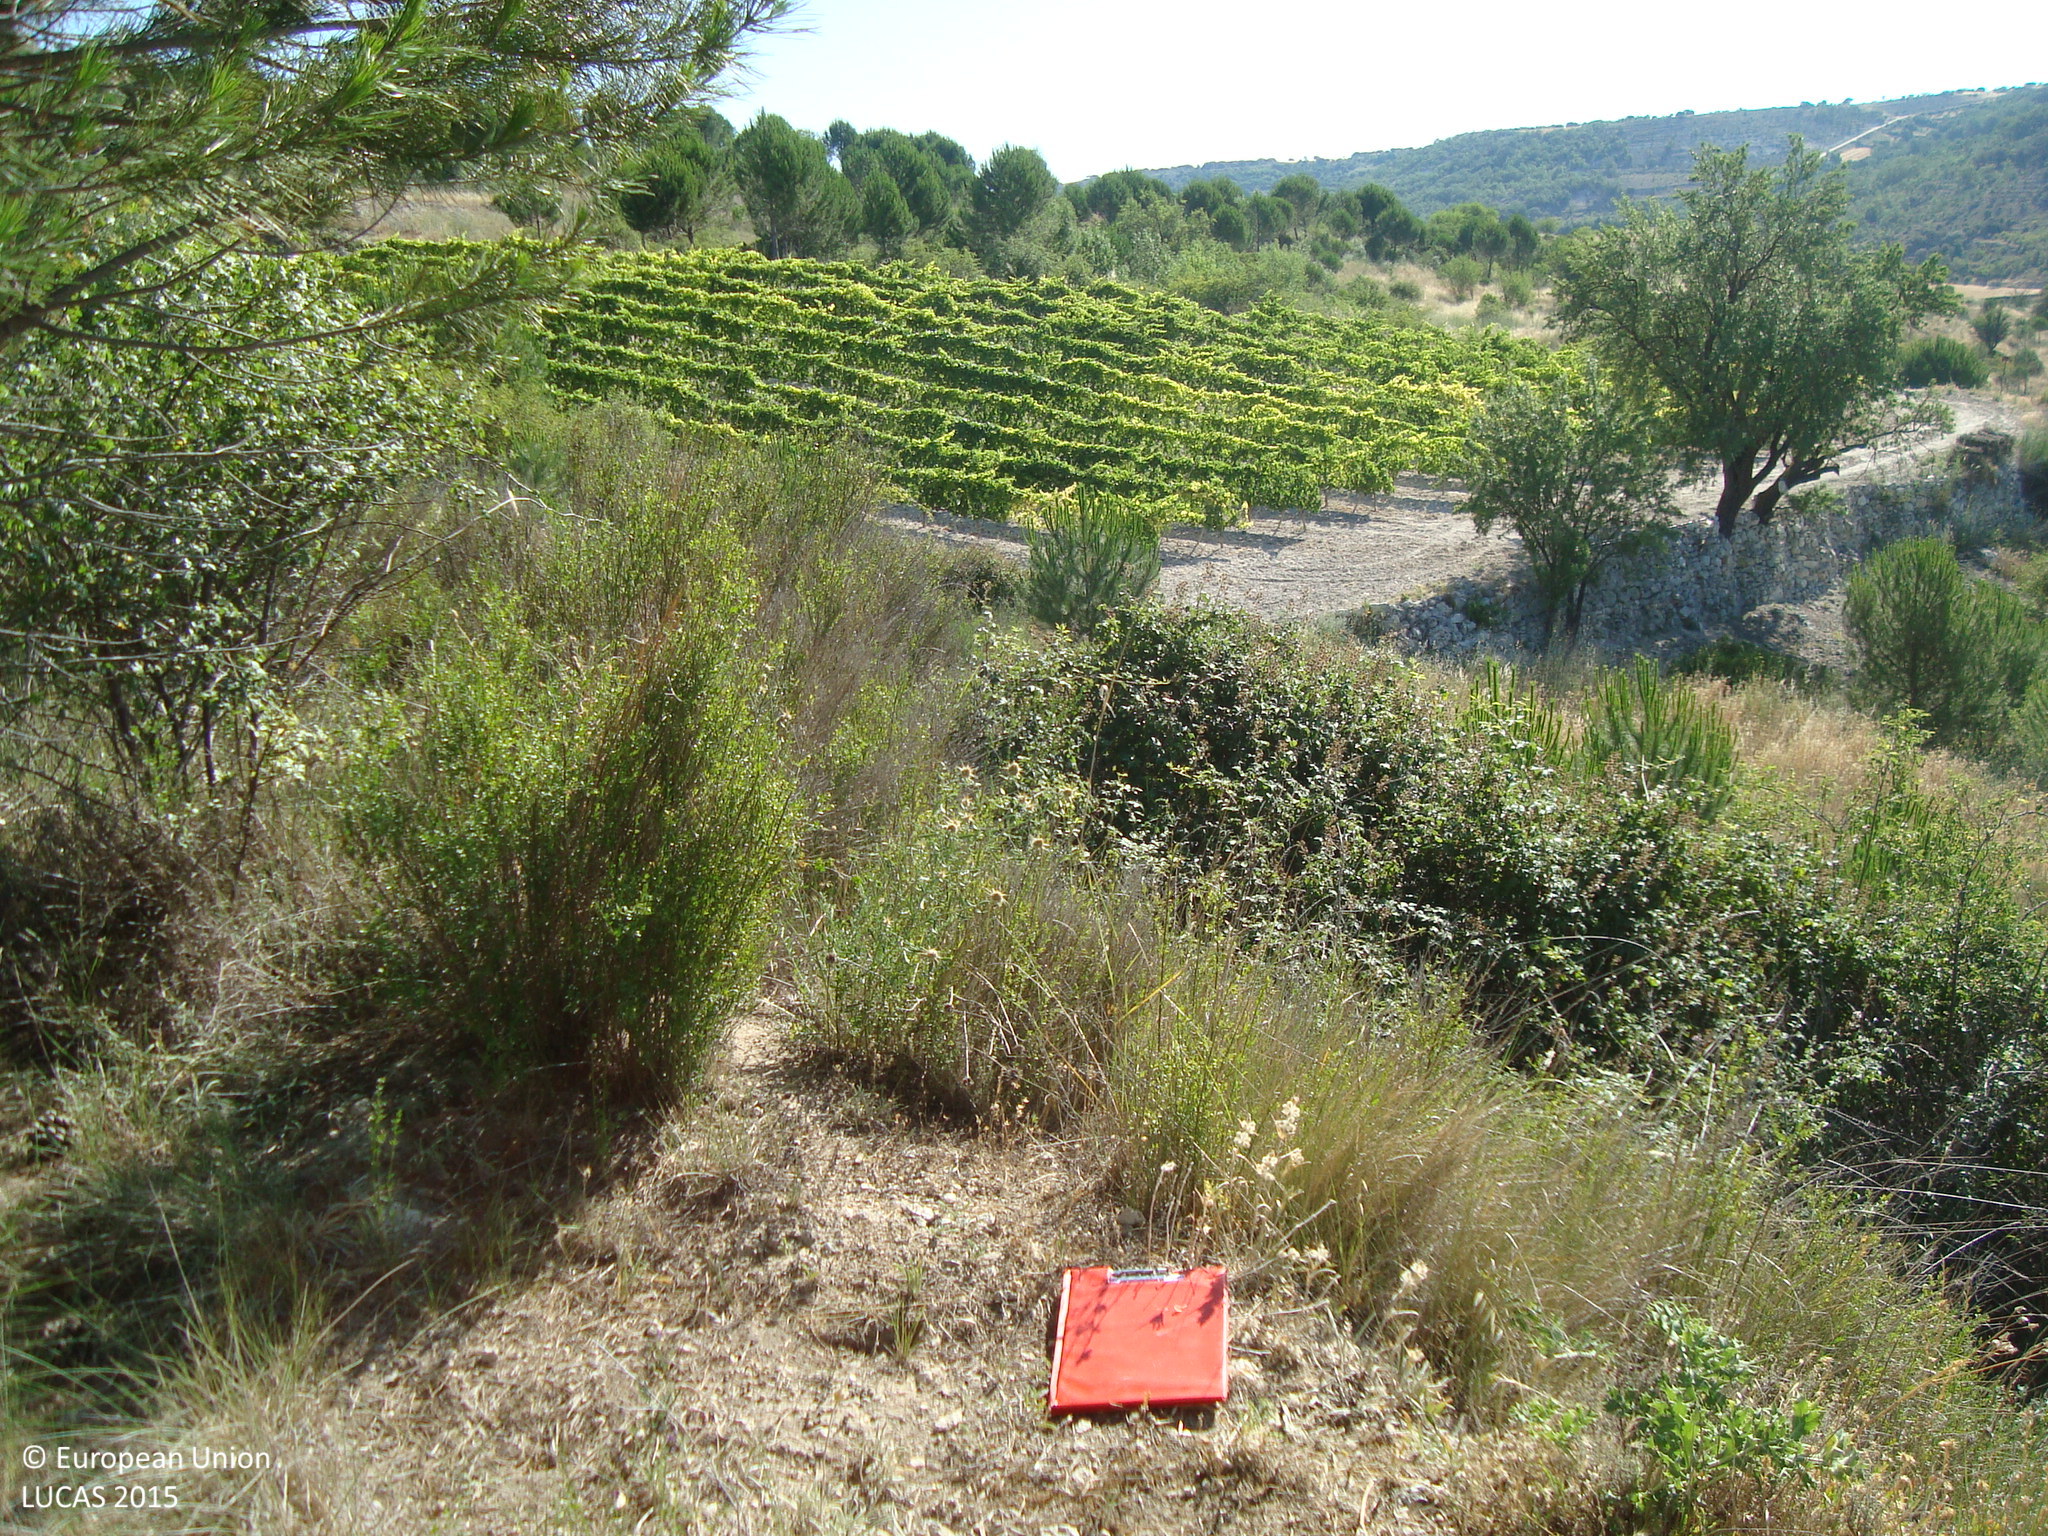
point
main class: Woodland
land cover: Pine dominated coniferous woodland
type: coniferous forest of the mediterranean region
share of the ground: 50 - 75 %
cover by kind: coniferous forest trees 60 %, shrubs 20 %, herbaceous plants 10 %, unconsolidated bare surface 10 %
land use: Forestry
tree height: > 5 m
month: July
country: ES
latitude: 41.6303
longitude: -4.0661
